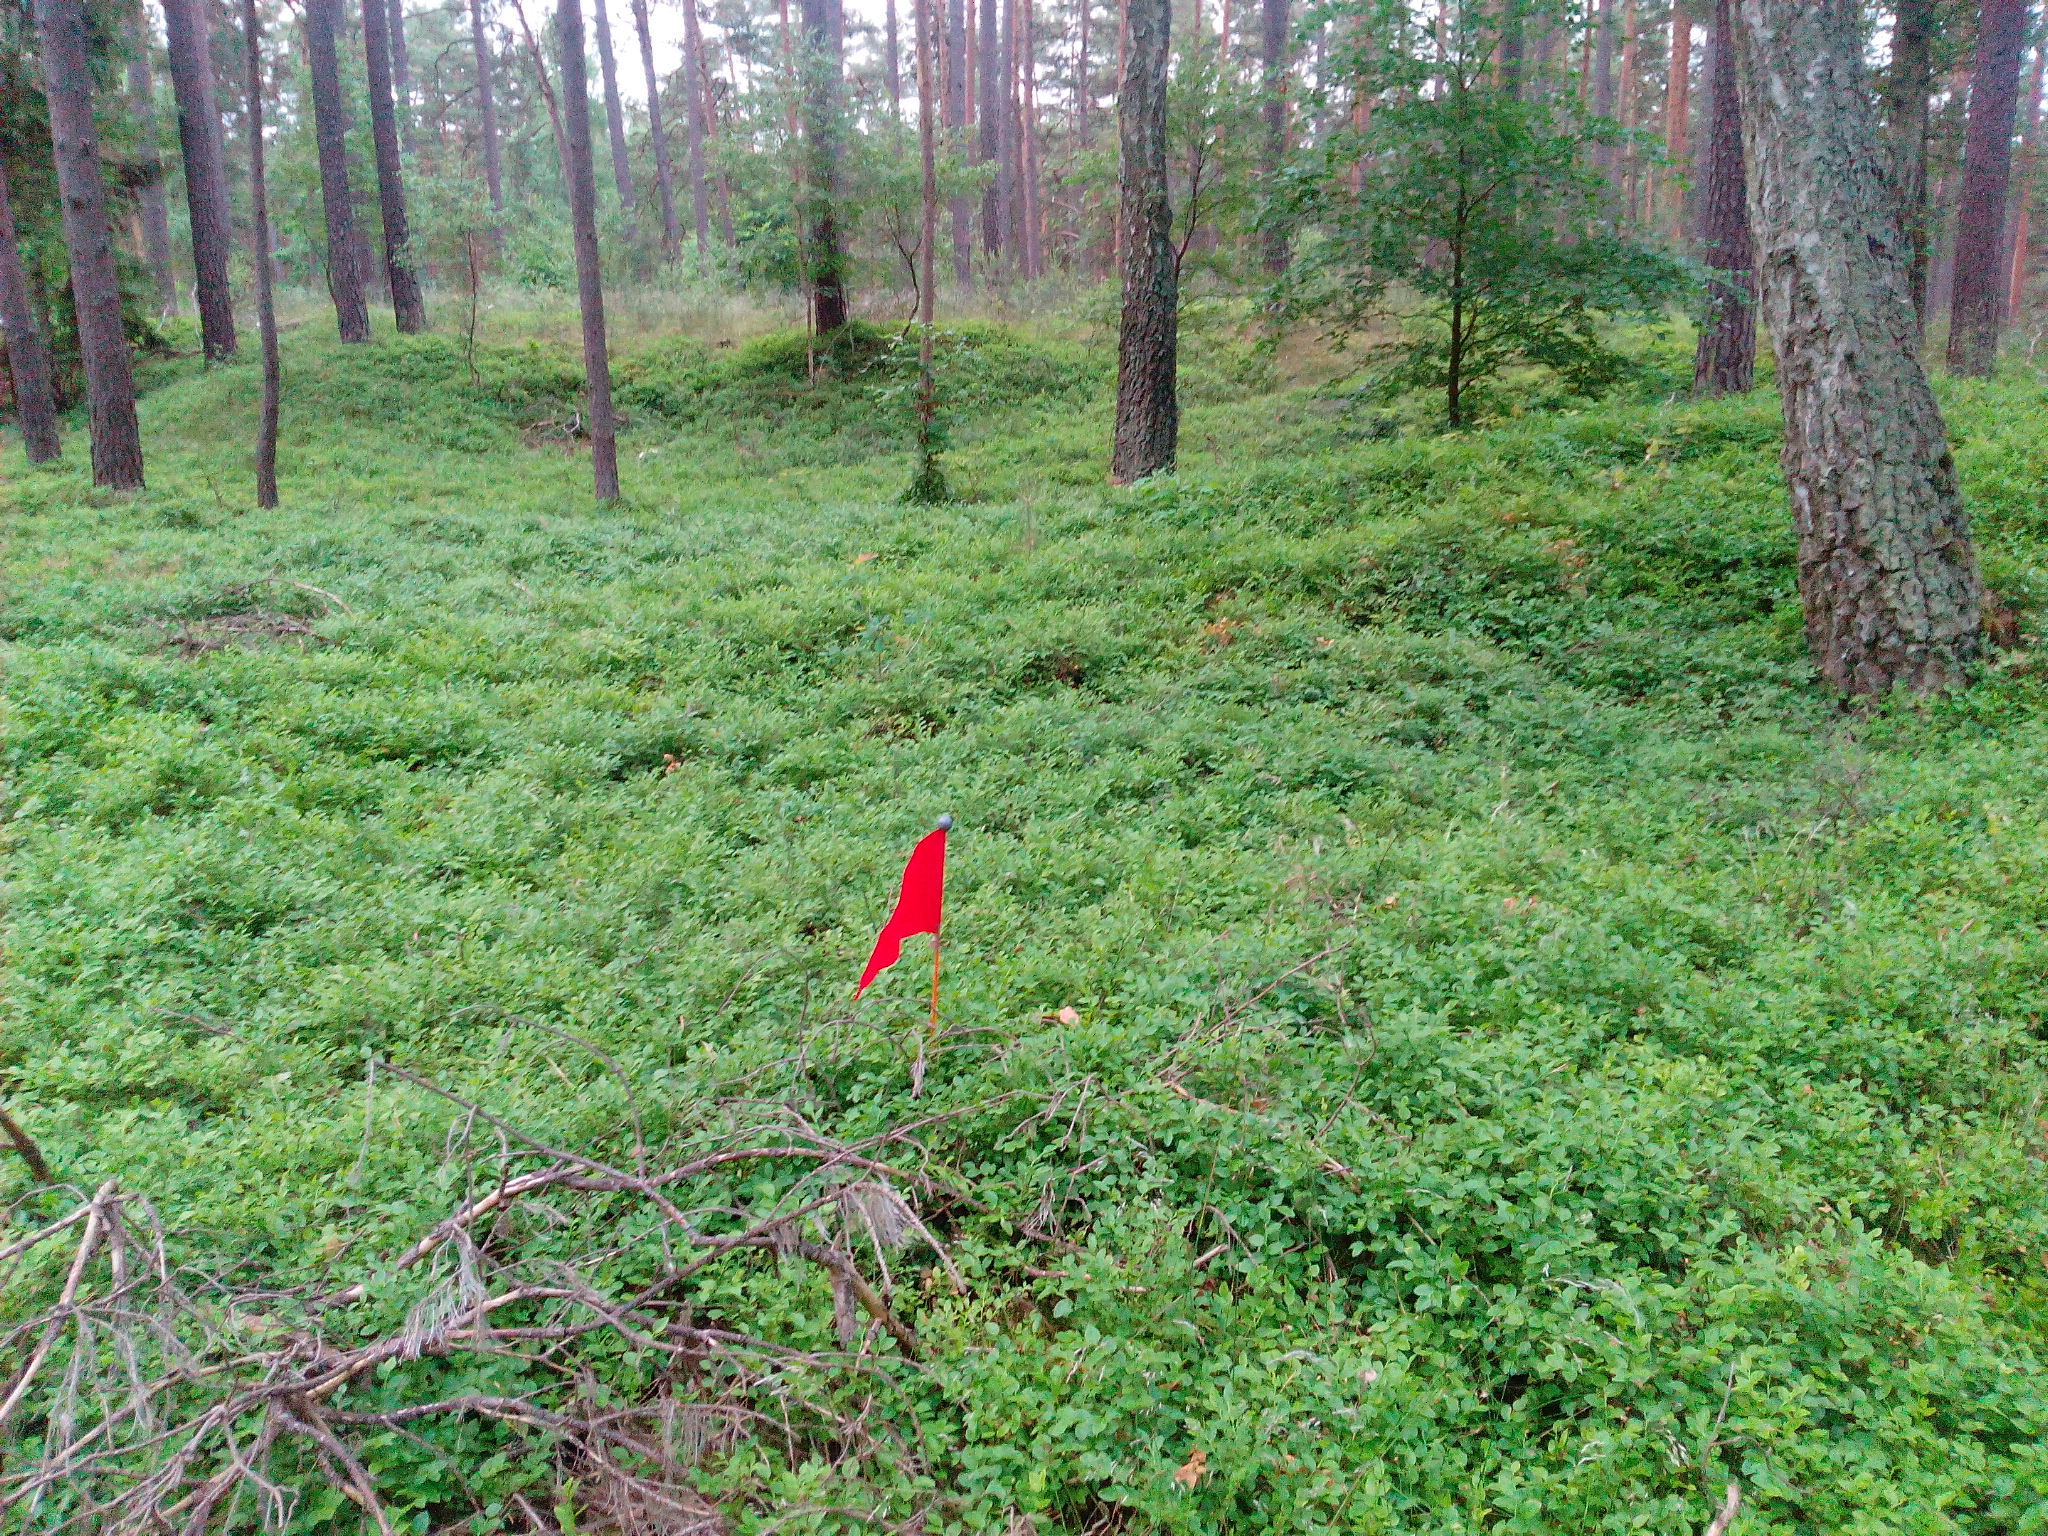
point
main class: Woodland
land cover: Pine dominated coniferous woodland
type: hemiboreal forest and nemoral coniferous forest and mixed broadleaved-coniferous forest
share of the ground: 50 - 75 %
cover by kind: coniferous forest trees 55 %, herbaceous plants 40 %, lichens and mosses 5 %
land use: Forestry
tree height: > 5 m
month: June
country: DE
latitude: 53.1981
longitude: 13.1882
